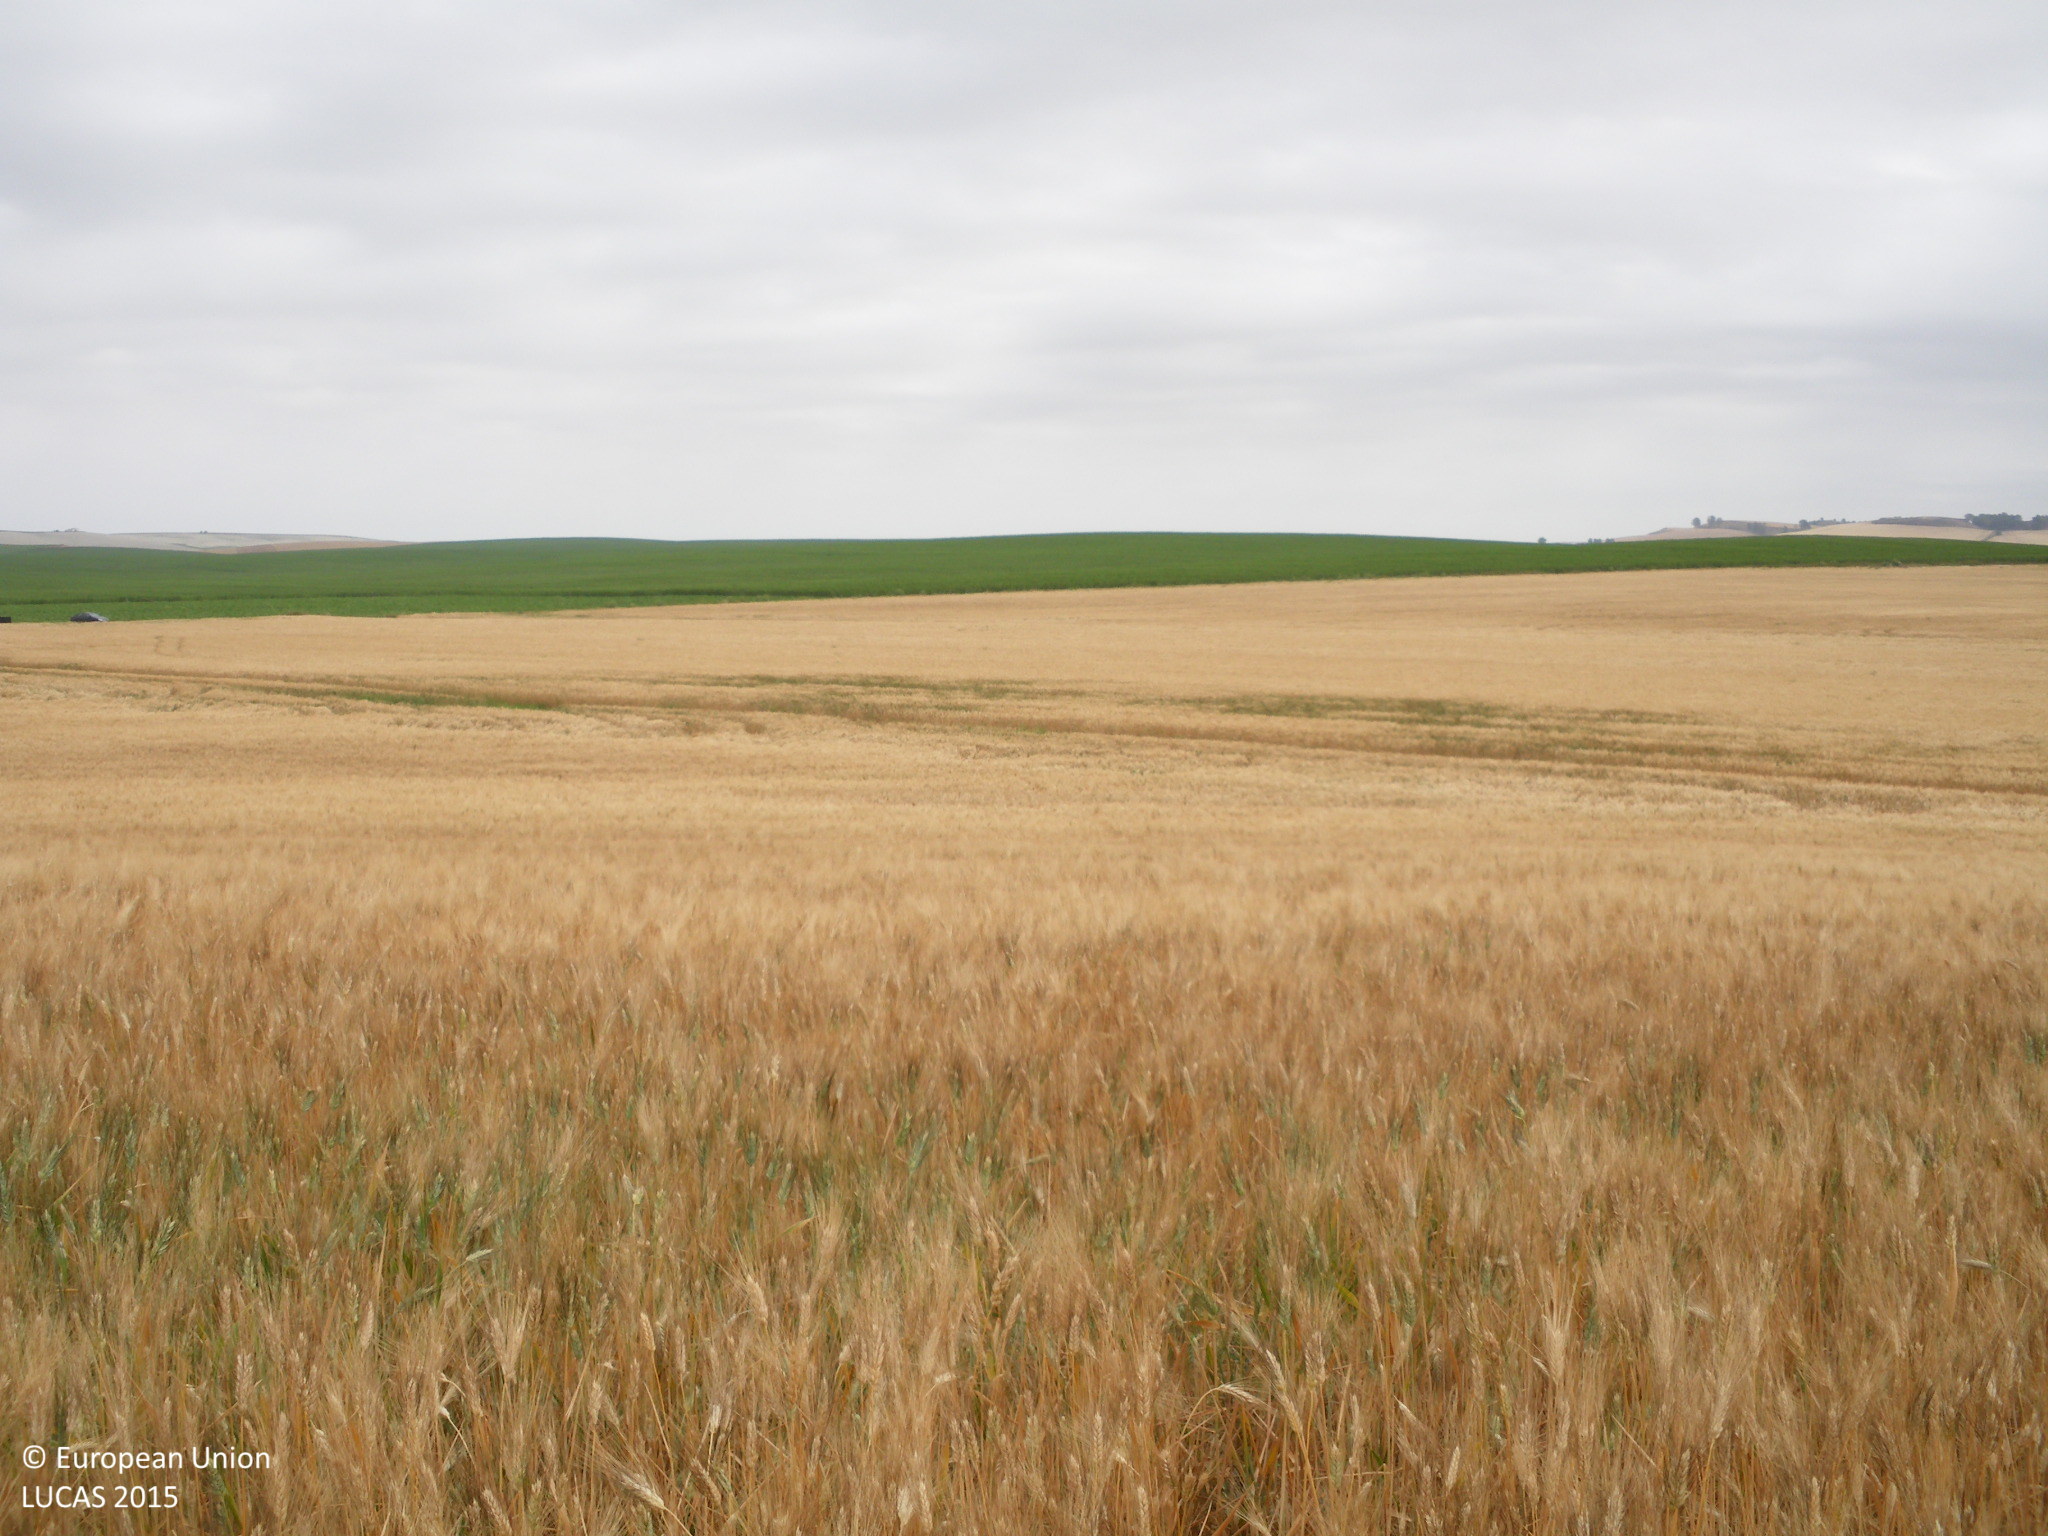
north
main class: Cropland
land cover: Durum wheat
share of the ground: > 75 %
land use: Agriculture (excluding fallow land and kitchen gardens)
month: May
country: ES
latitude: 36.7544
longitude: -6.2002
